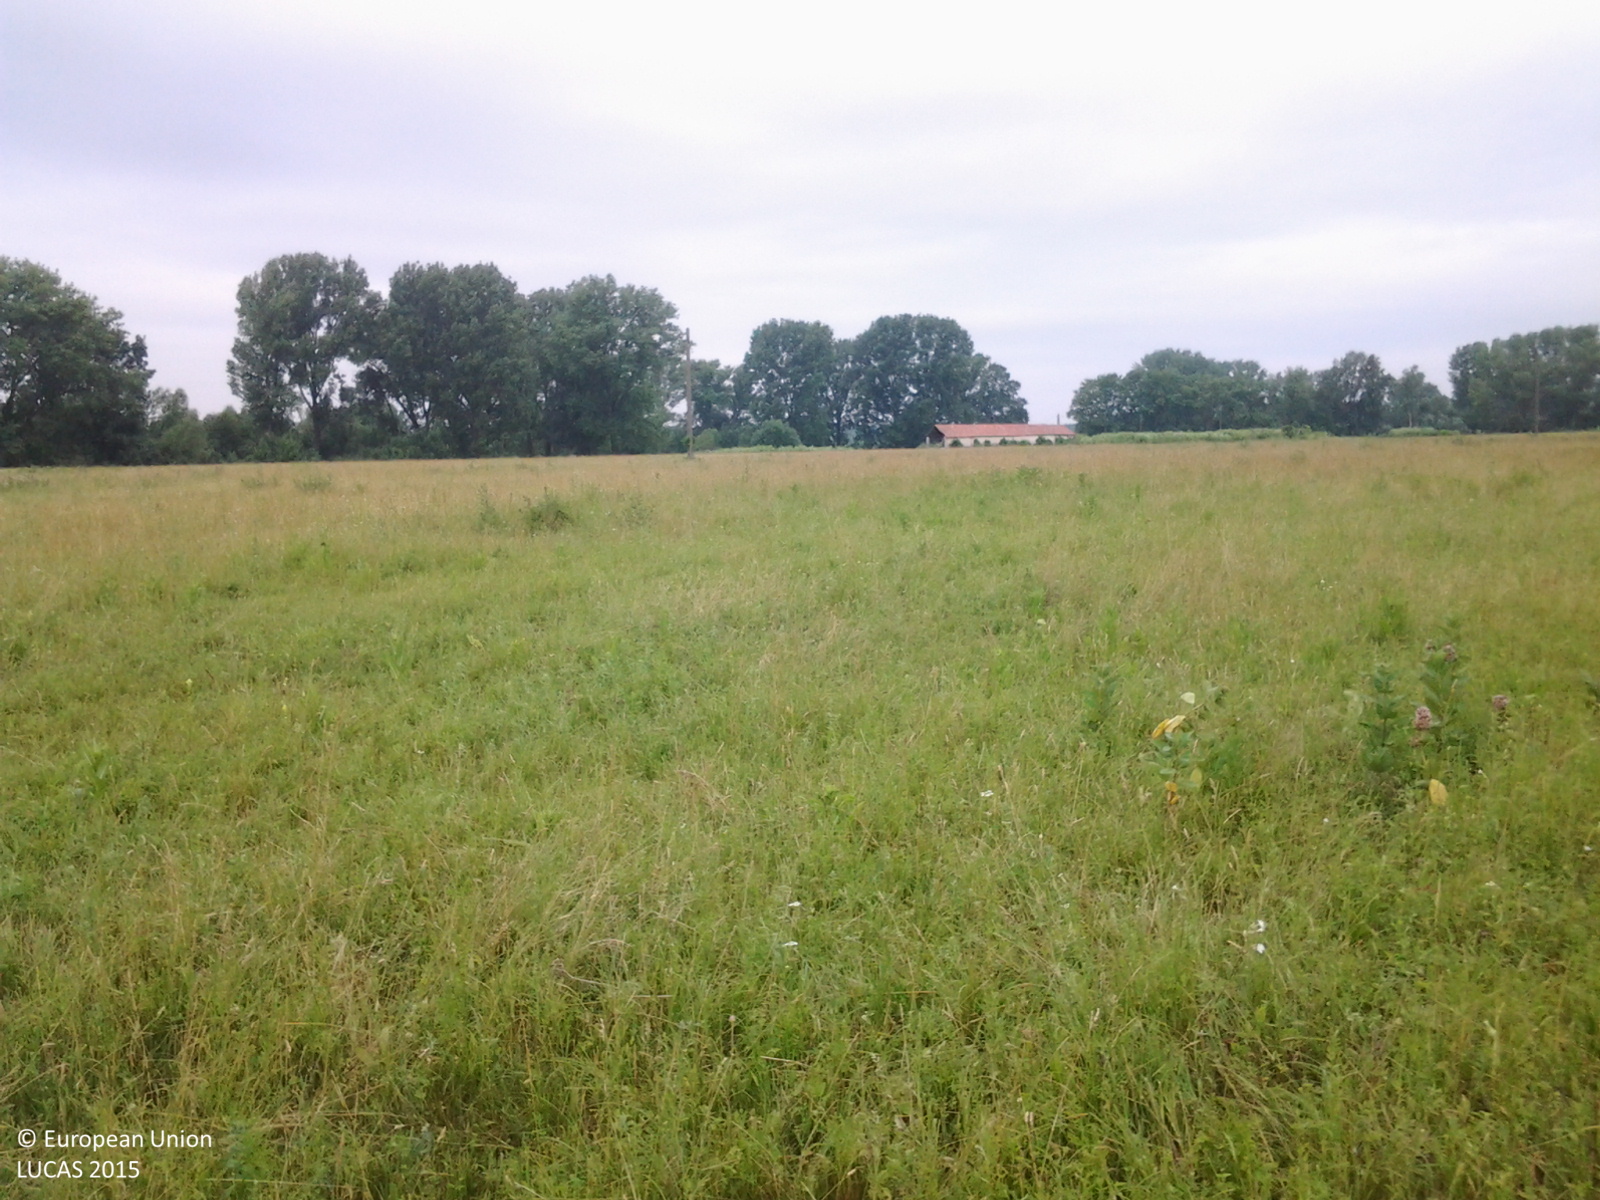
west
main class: Grassland
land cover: Grassland without tree/shrub cover
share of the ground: > 75 %
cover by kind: herbaceous plants 100 %
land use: Agriculture (excluding fallow land and kitchen gardens)
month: June
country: HU
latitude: 46.4819
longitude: 19.1720
